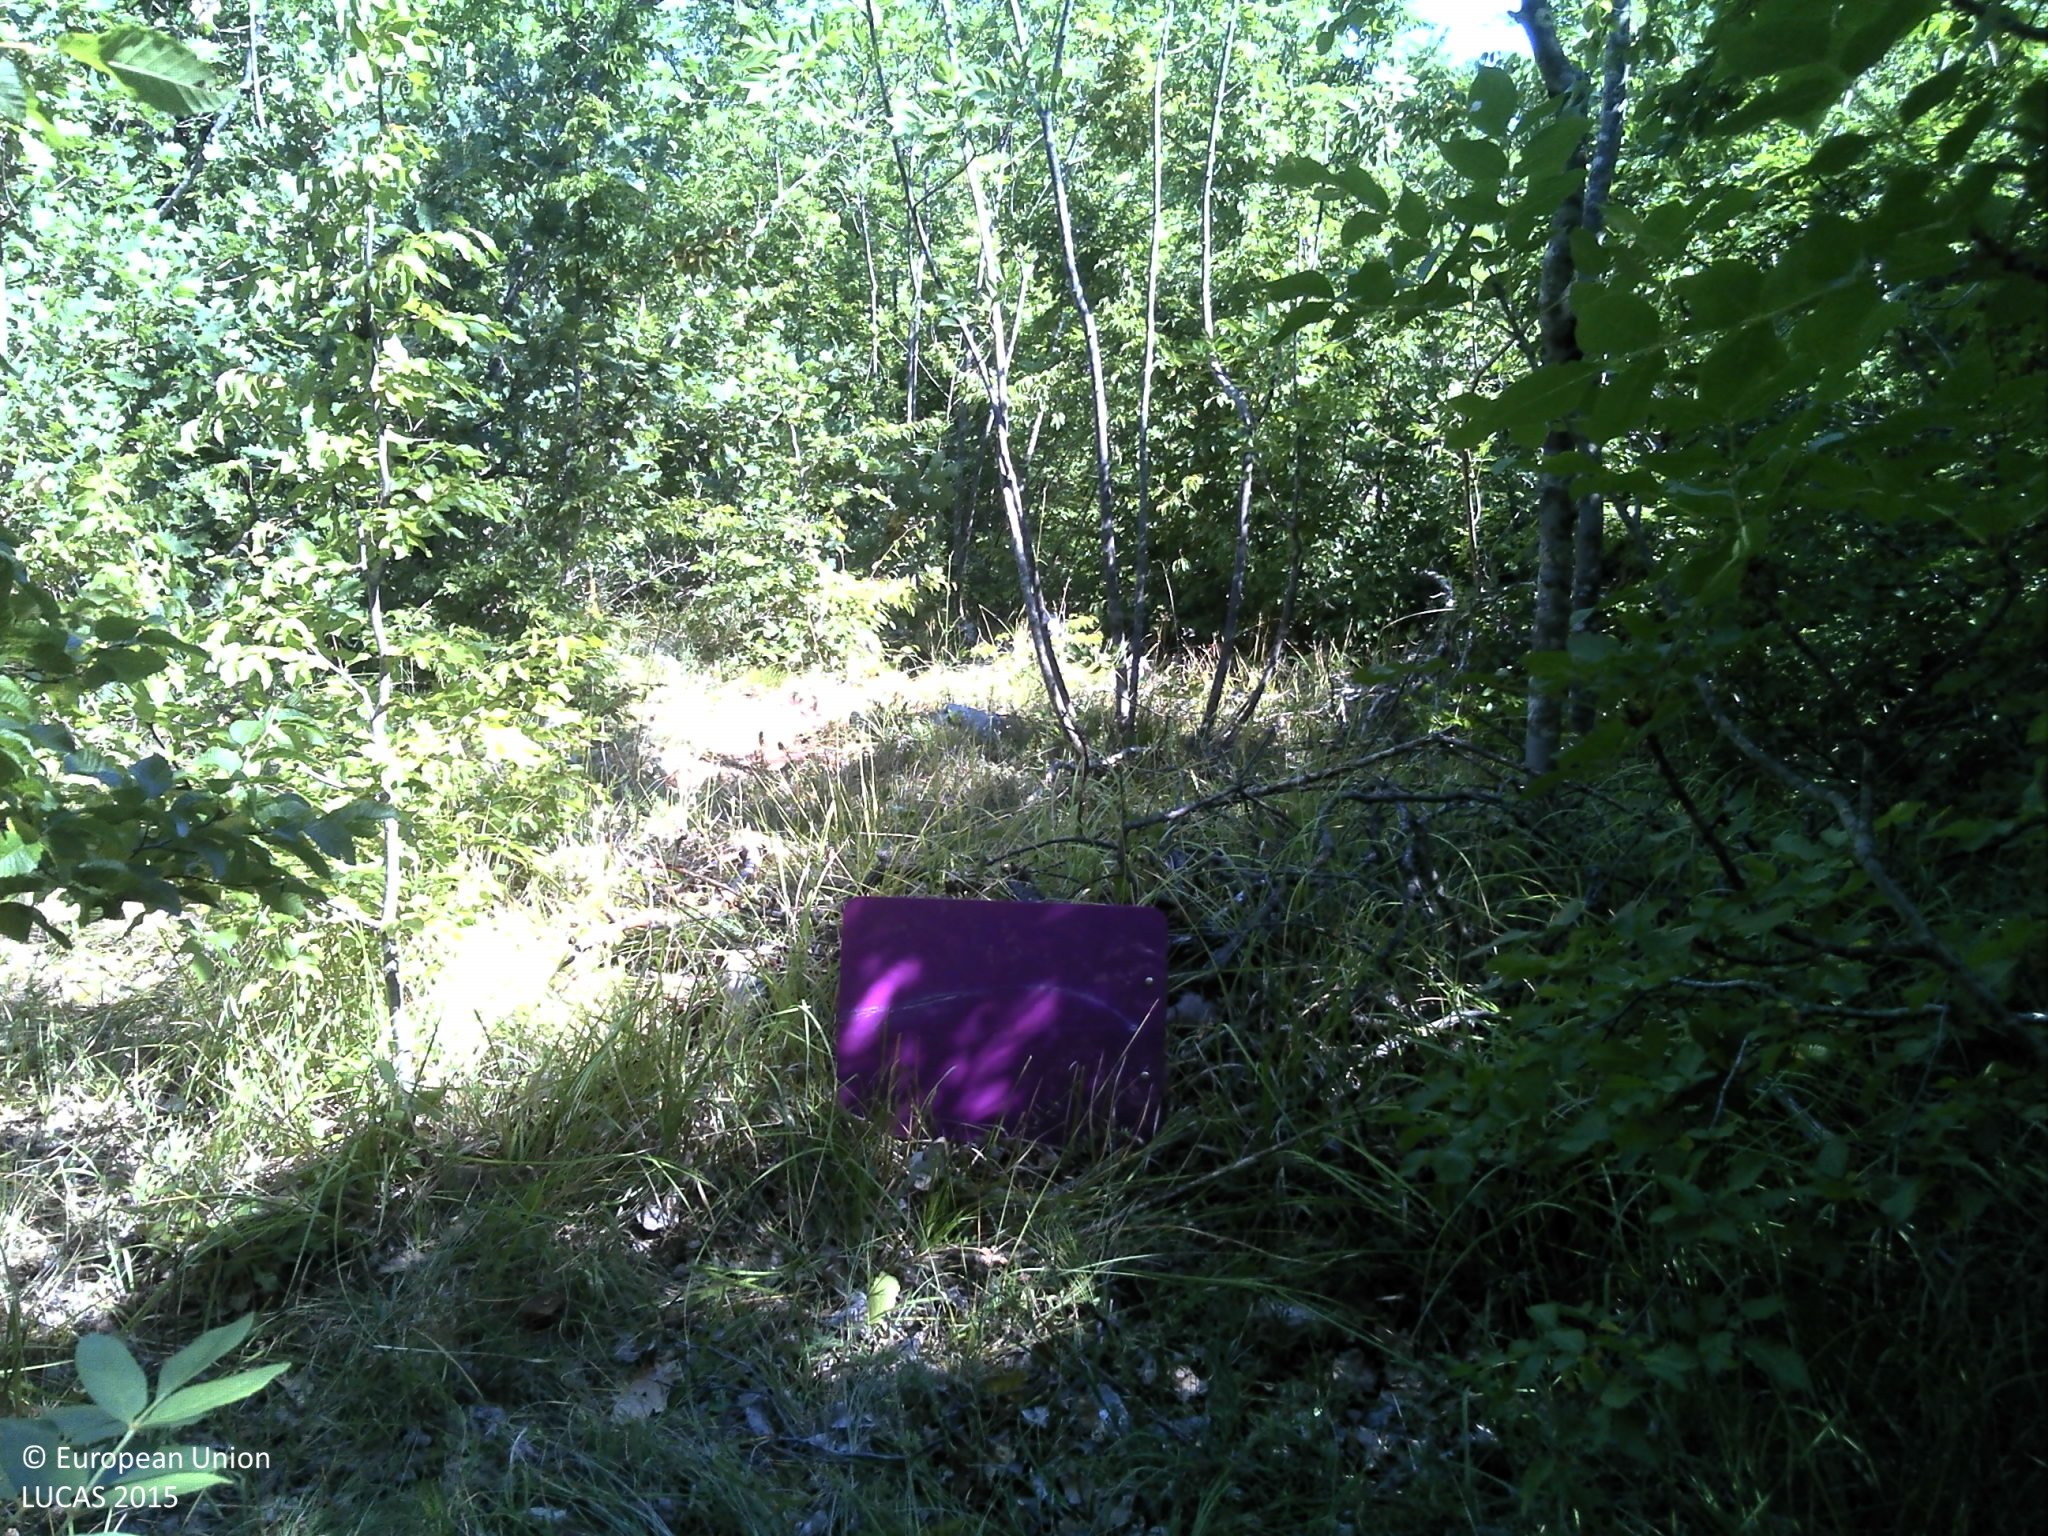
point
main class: Shrubland
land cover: Shrubland with sparse tree cover
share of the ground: > 75 %
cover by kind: shrubs 75 %, herbaceous plants 10 %, broadleaved forest trees 5 %, lichens and mosses 5 %, consolidated bare surface 5 %
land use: Semi-natural and natural areas not in use
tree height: > 5 m
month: July
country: HR
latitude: 43.5521
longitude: 17.0104
